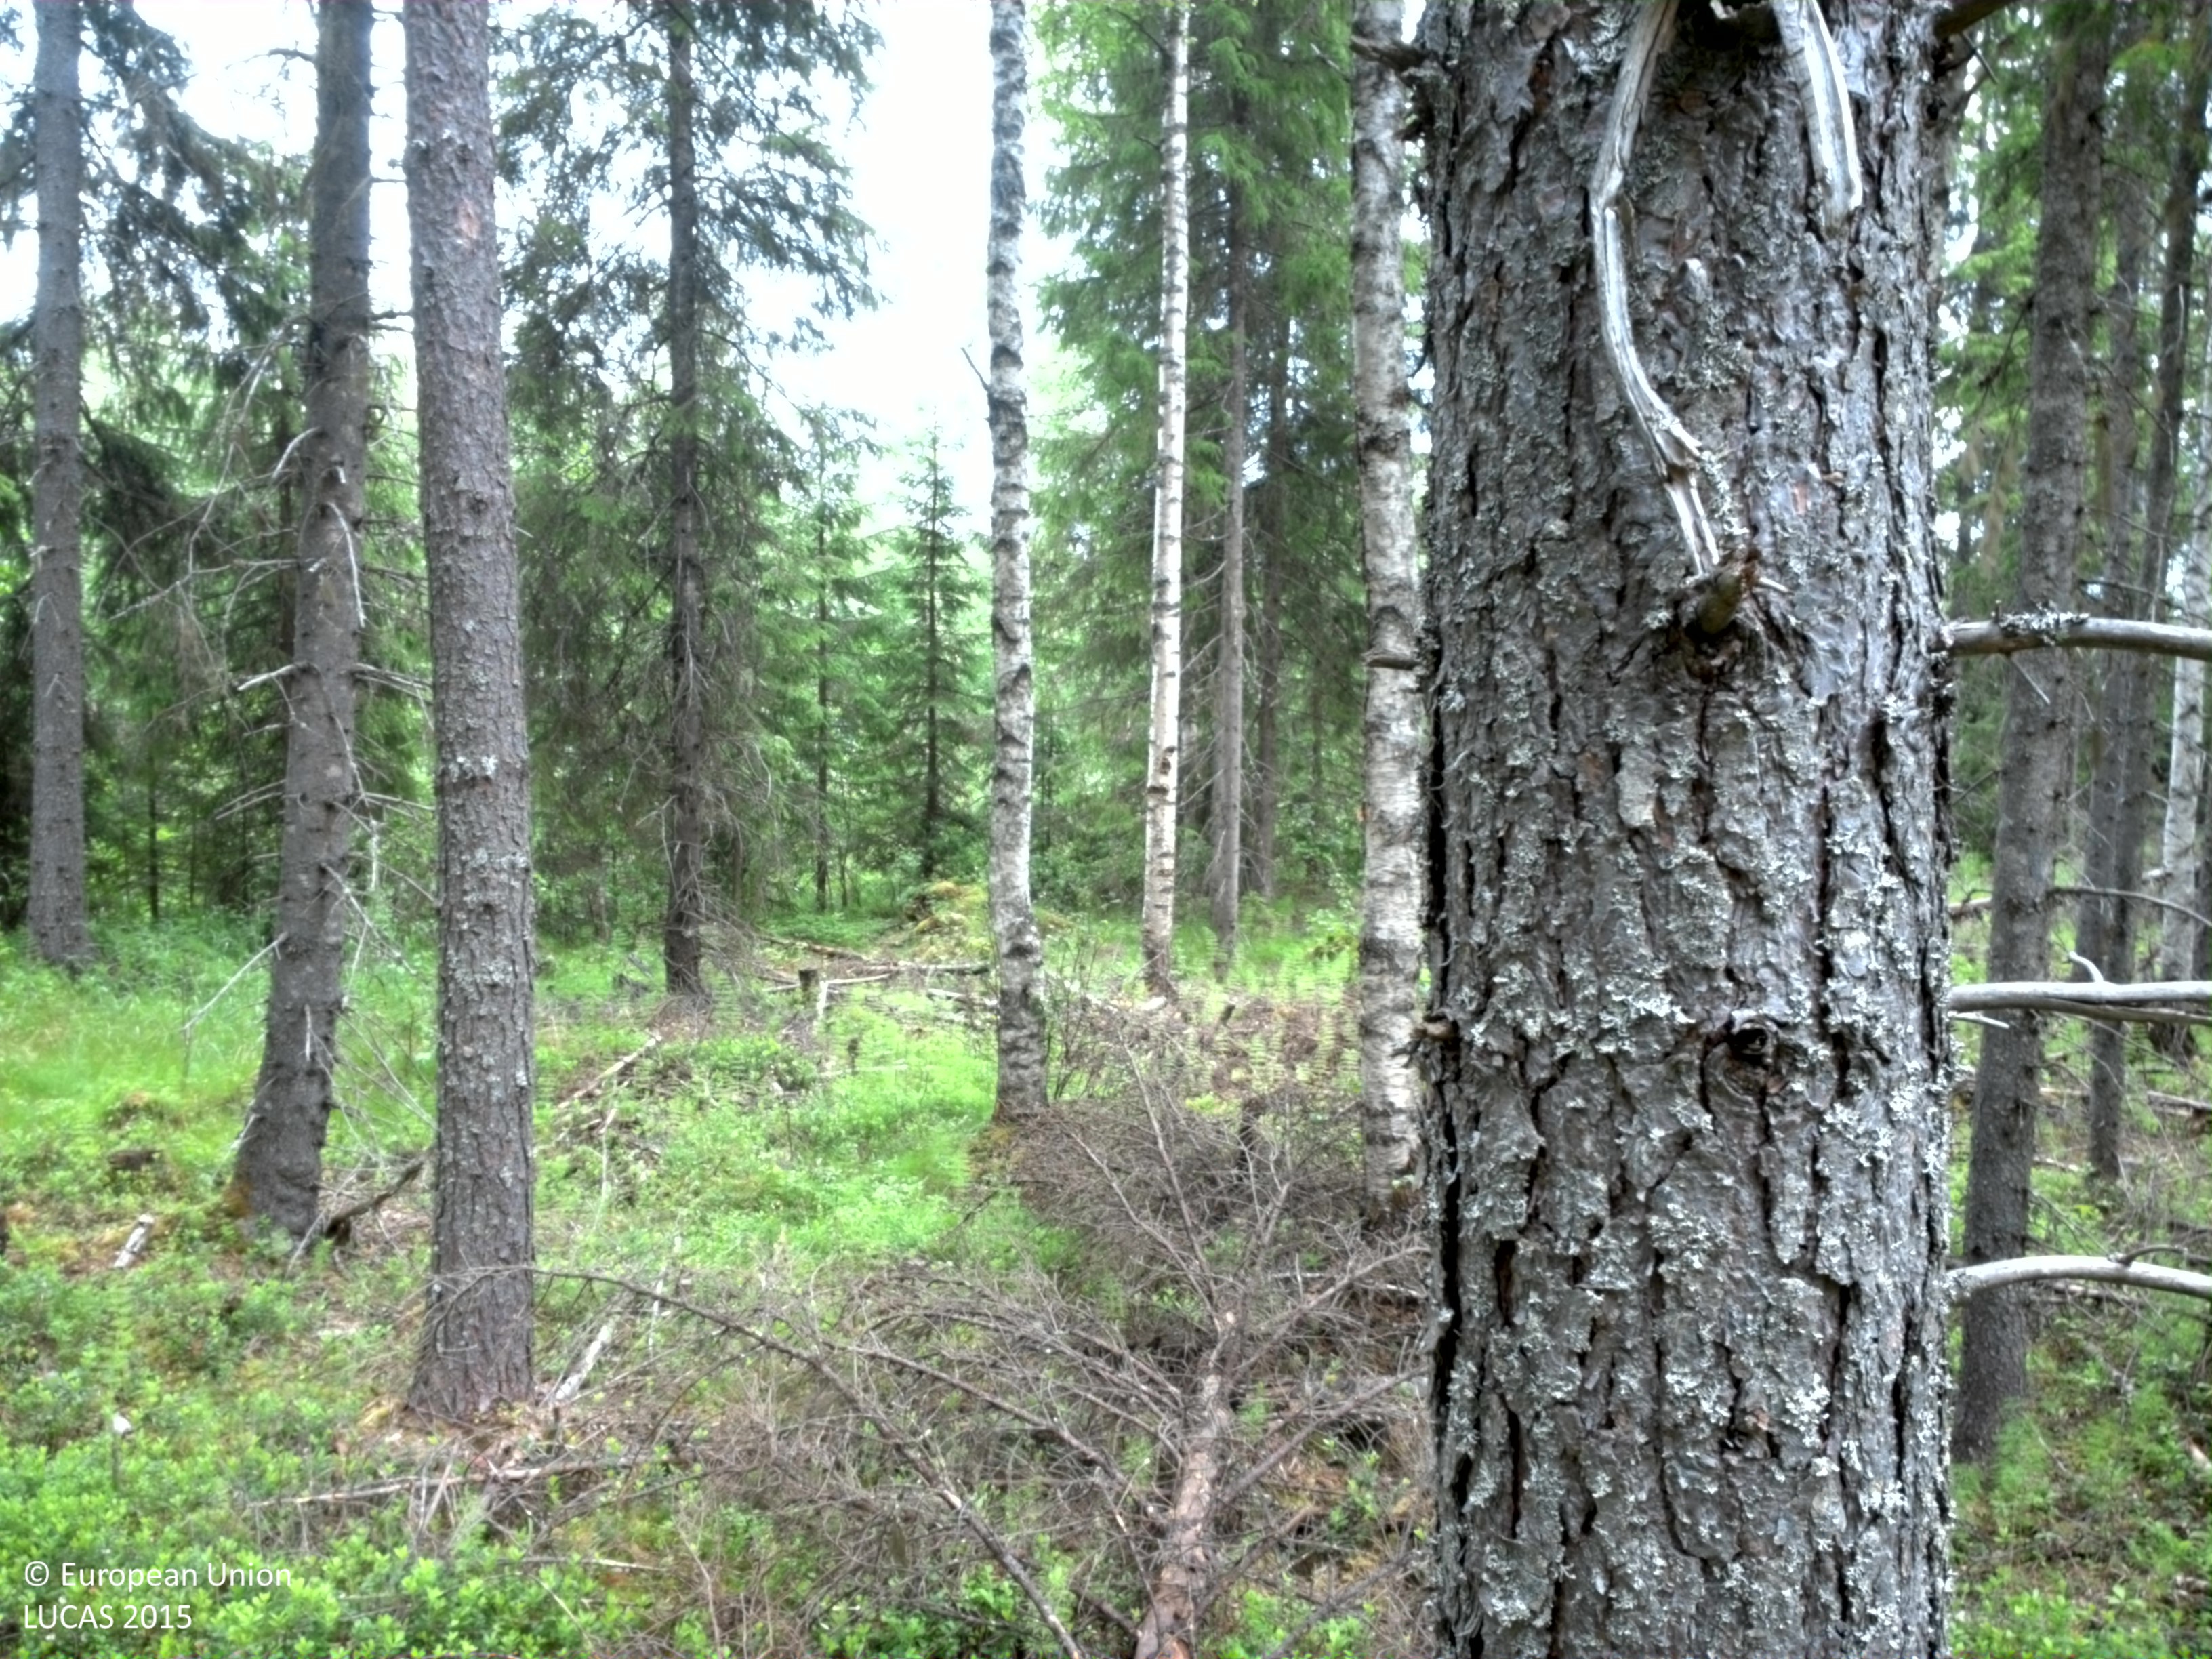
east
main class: Woodland
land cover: Spruce dominated coniferous woodland
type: boreal forest
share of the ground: 50 - 75 %
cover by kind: coniferous forest trees 45 %, shrubs 35 %, broadleaved forest trees 15 %, herbaceous plants 5 %
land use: Forestry
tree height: > 5 m
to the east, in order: Spruce dominated coniferous woodland; Ditches and canals; Abandoned hedges; Grassland with sparse tree/shrub cover; Broadleaved woodland; Ditches and canals; Grassland without tree/shrub cover; Ditches and canals; Abandoned hedges; Grassland without tree/shrub cover; Broadleaved woodland; Groves; Grassland without tree/shrub cover; Broadleaved woodland; Groves; Broadleaved woodland; Ditches and canals; Broadleaved woodland; Other mixed woodland
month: July
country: SE
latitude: 64.5346
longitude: 20.8814
